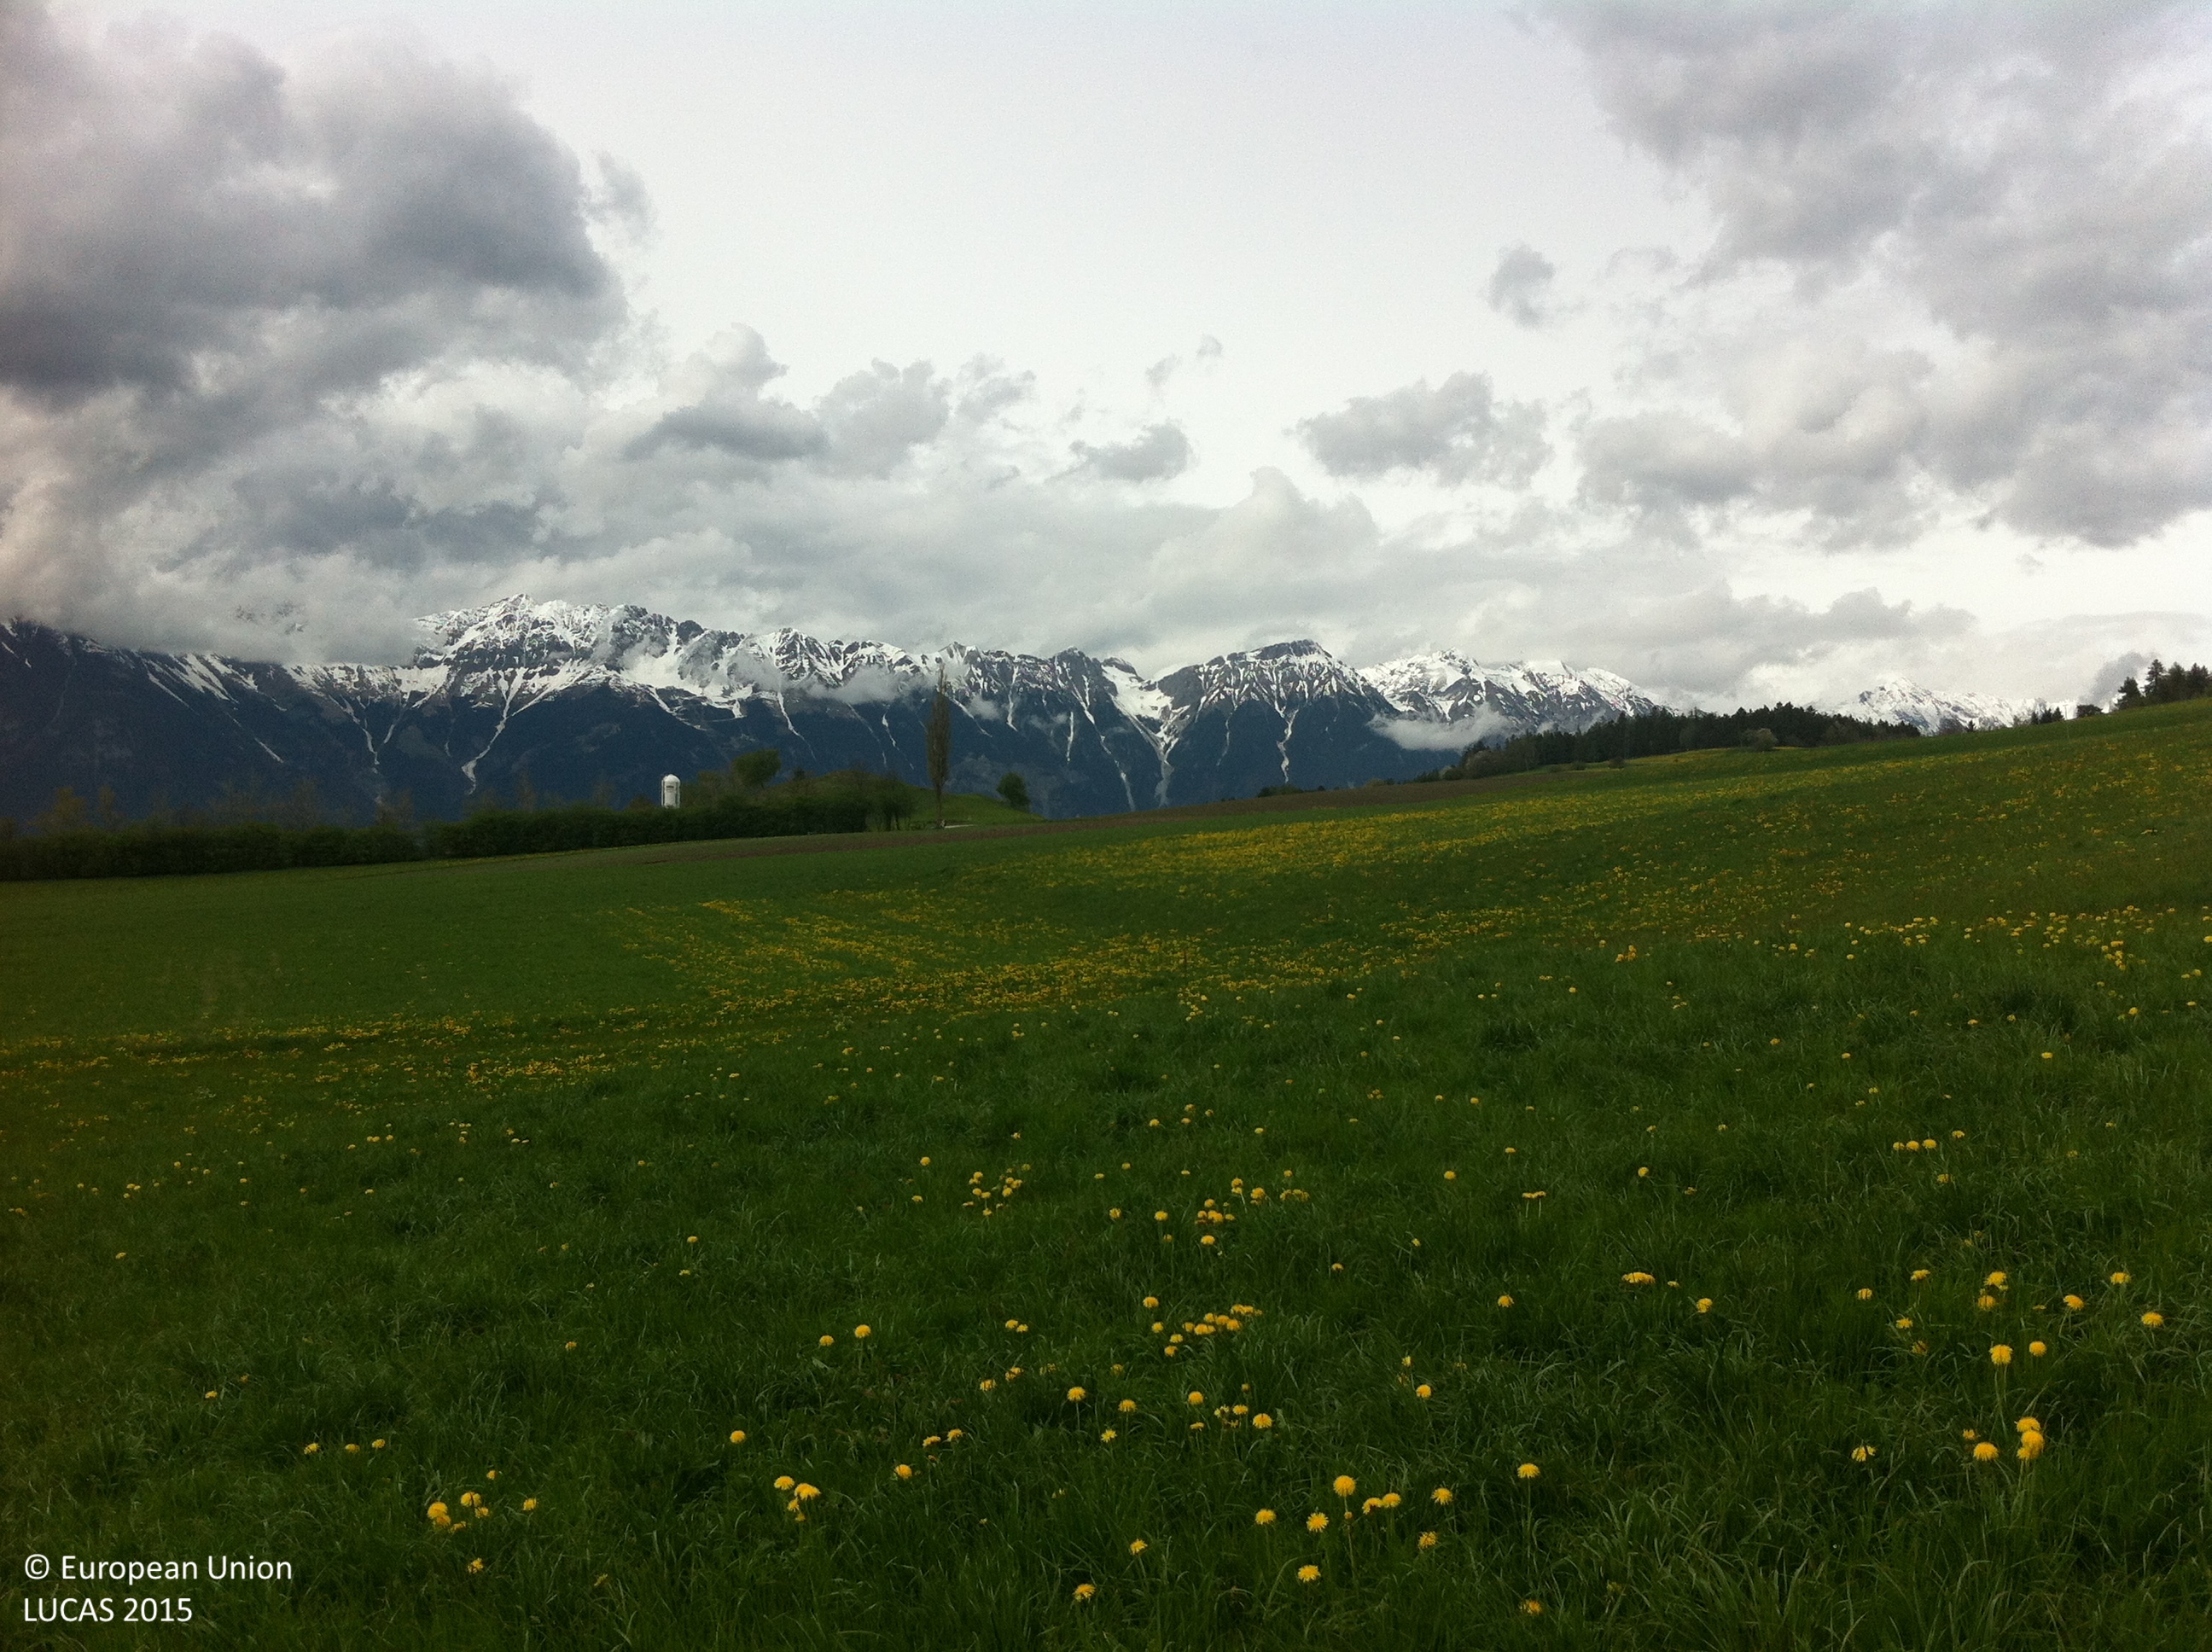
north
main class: Grassland
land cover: Grassland without tree/shrub cover
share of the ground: > 75 %
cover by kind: herbaceous plants 100 %
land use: Agriculture (excluding fallow land and kitchen gardens)
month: May
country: AT
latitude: 47.2064
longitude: 11.4113
